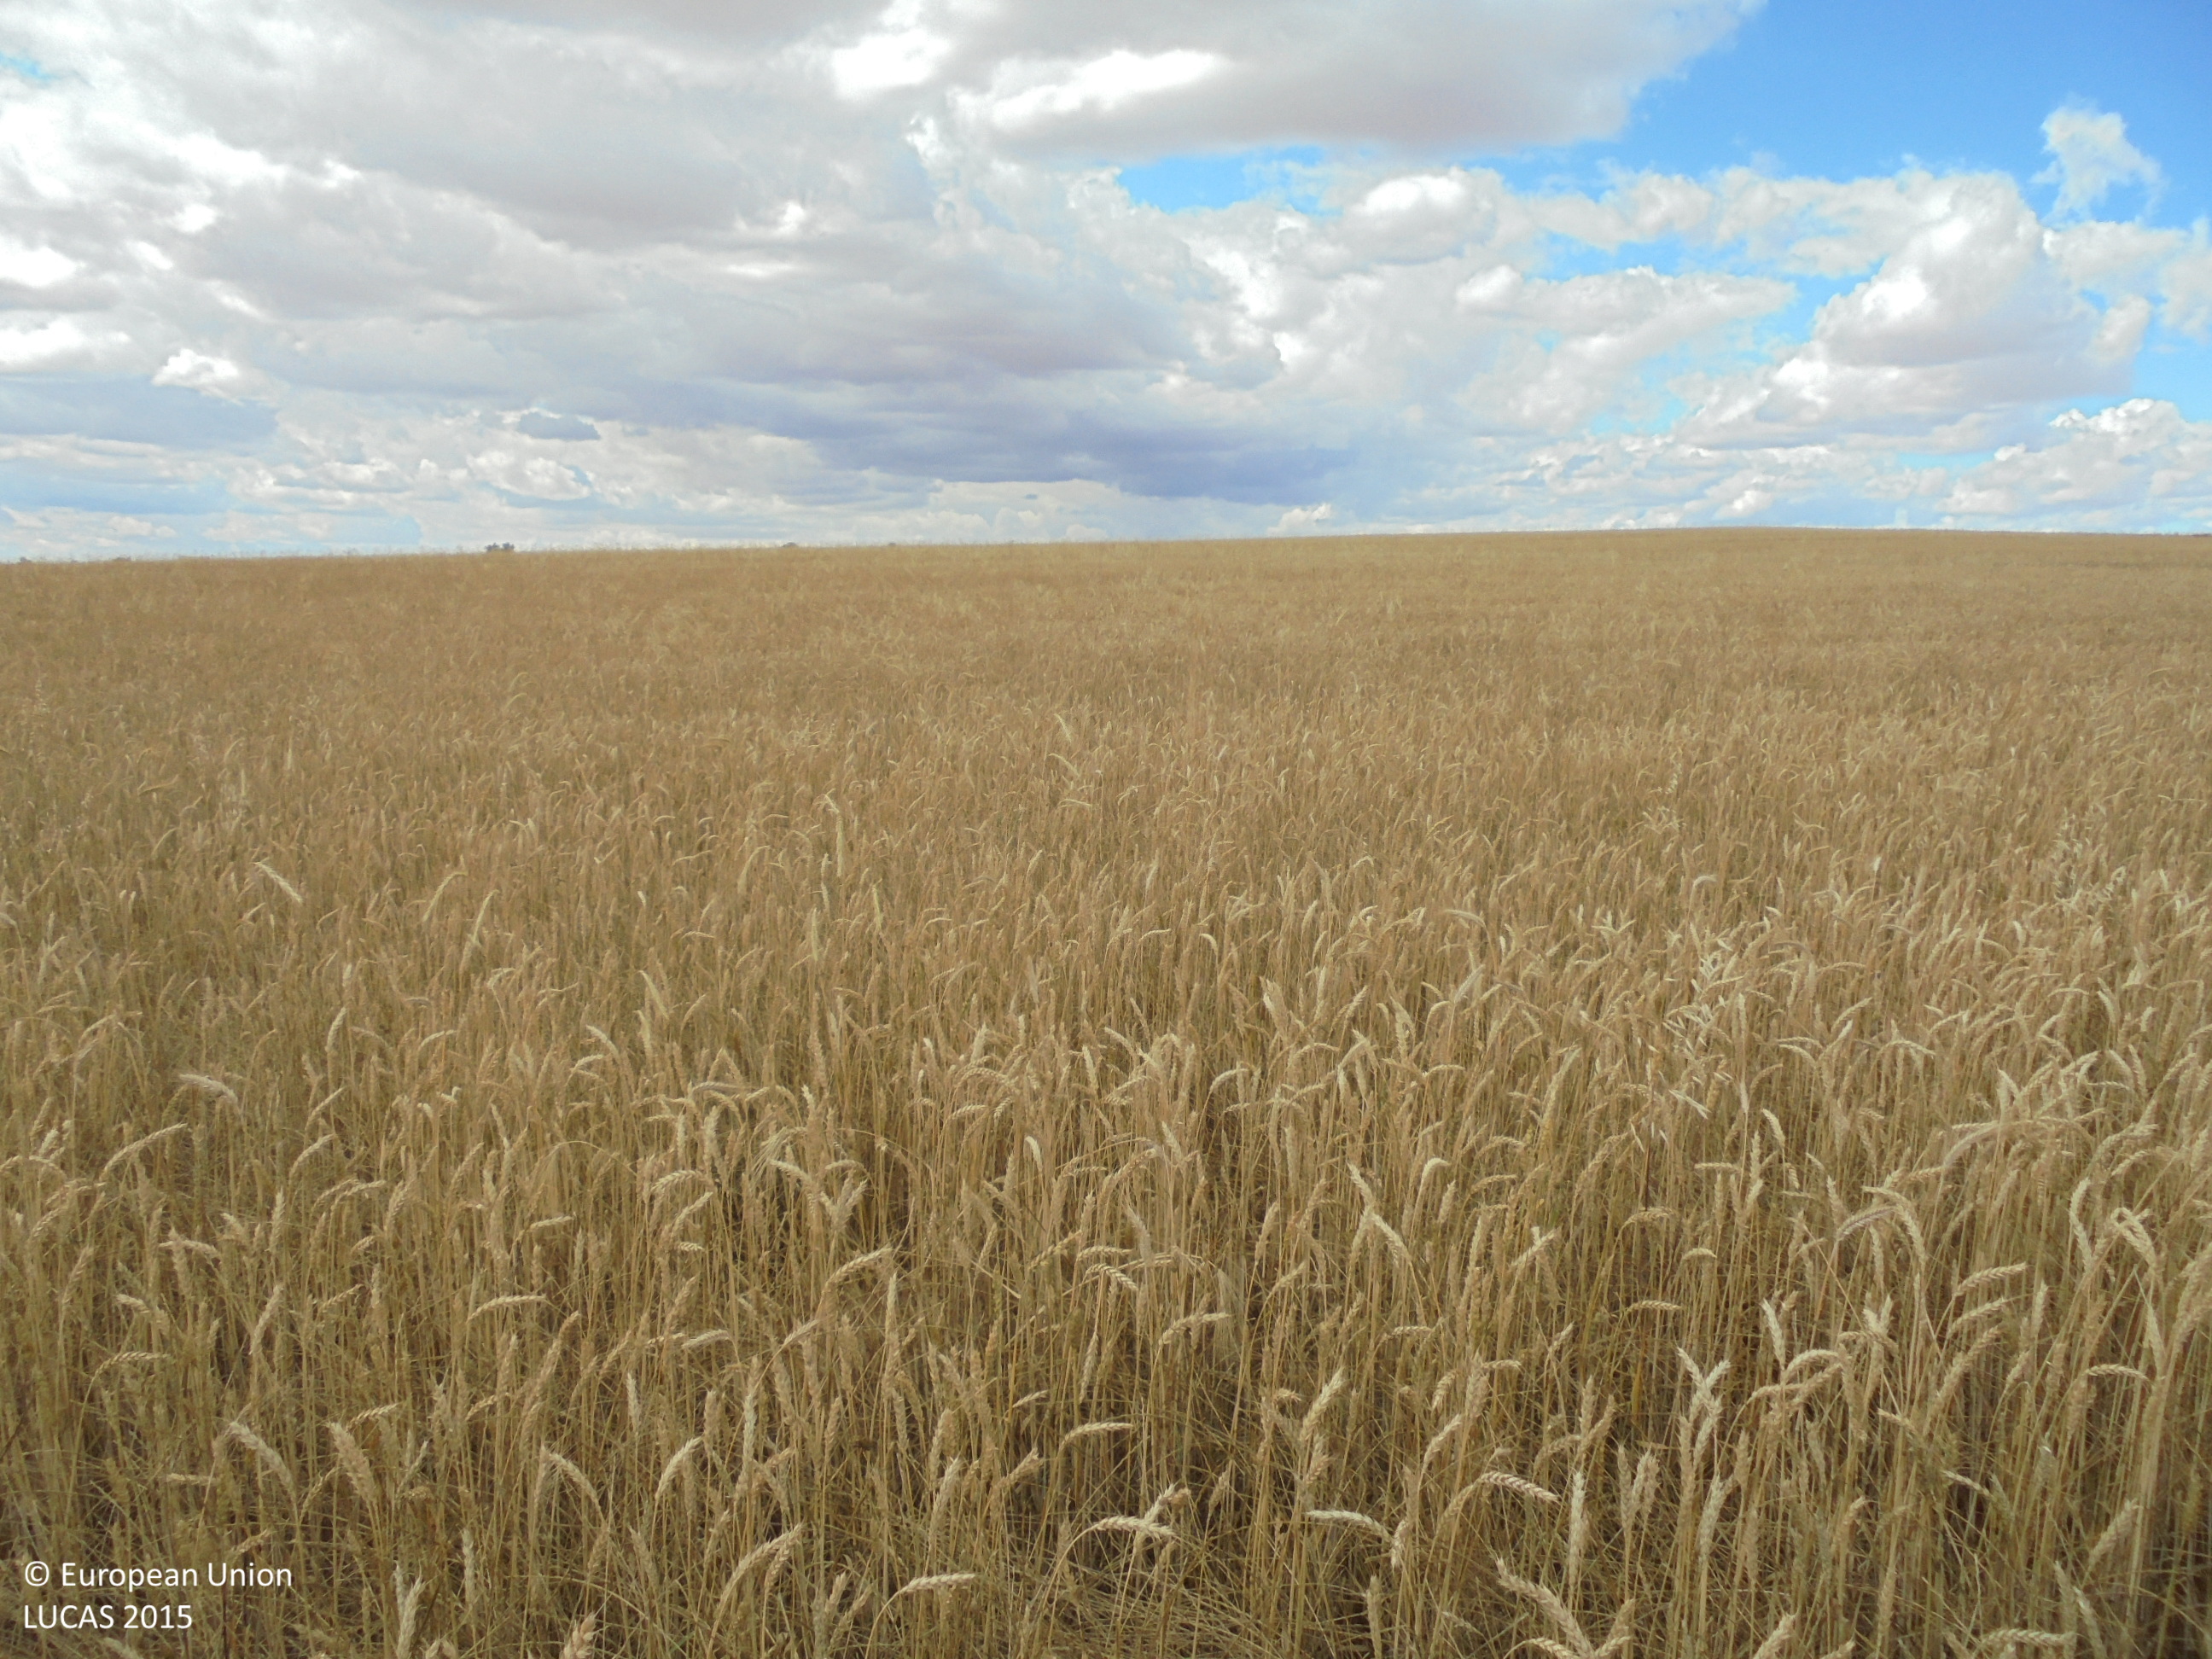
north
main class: Cropland
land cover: Durum wheat
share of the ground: > 75 %
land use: Agriculture (excluding fallow land and kitchen gardens)
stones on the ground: < 10 %
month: June
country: ES
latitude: 38.7578
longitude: -1.4217
